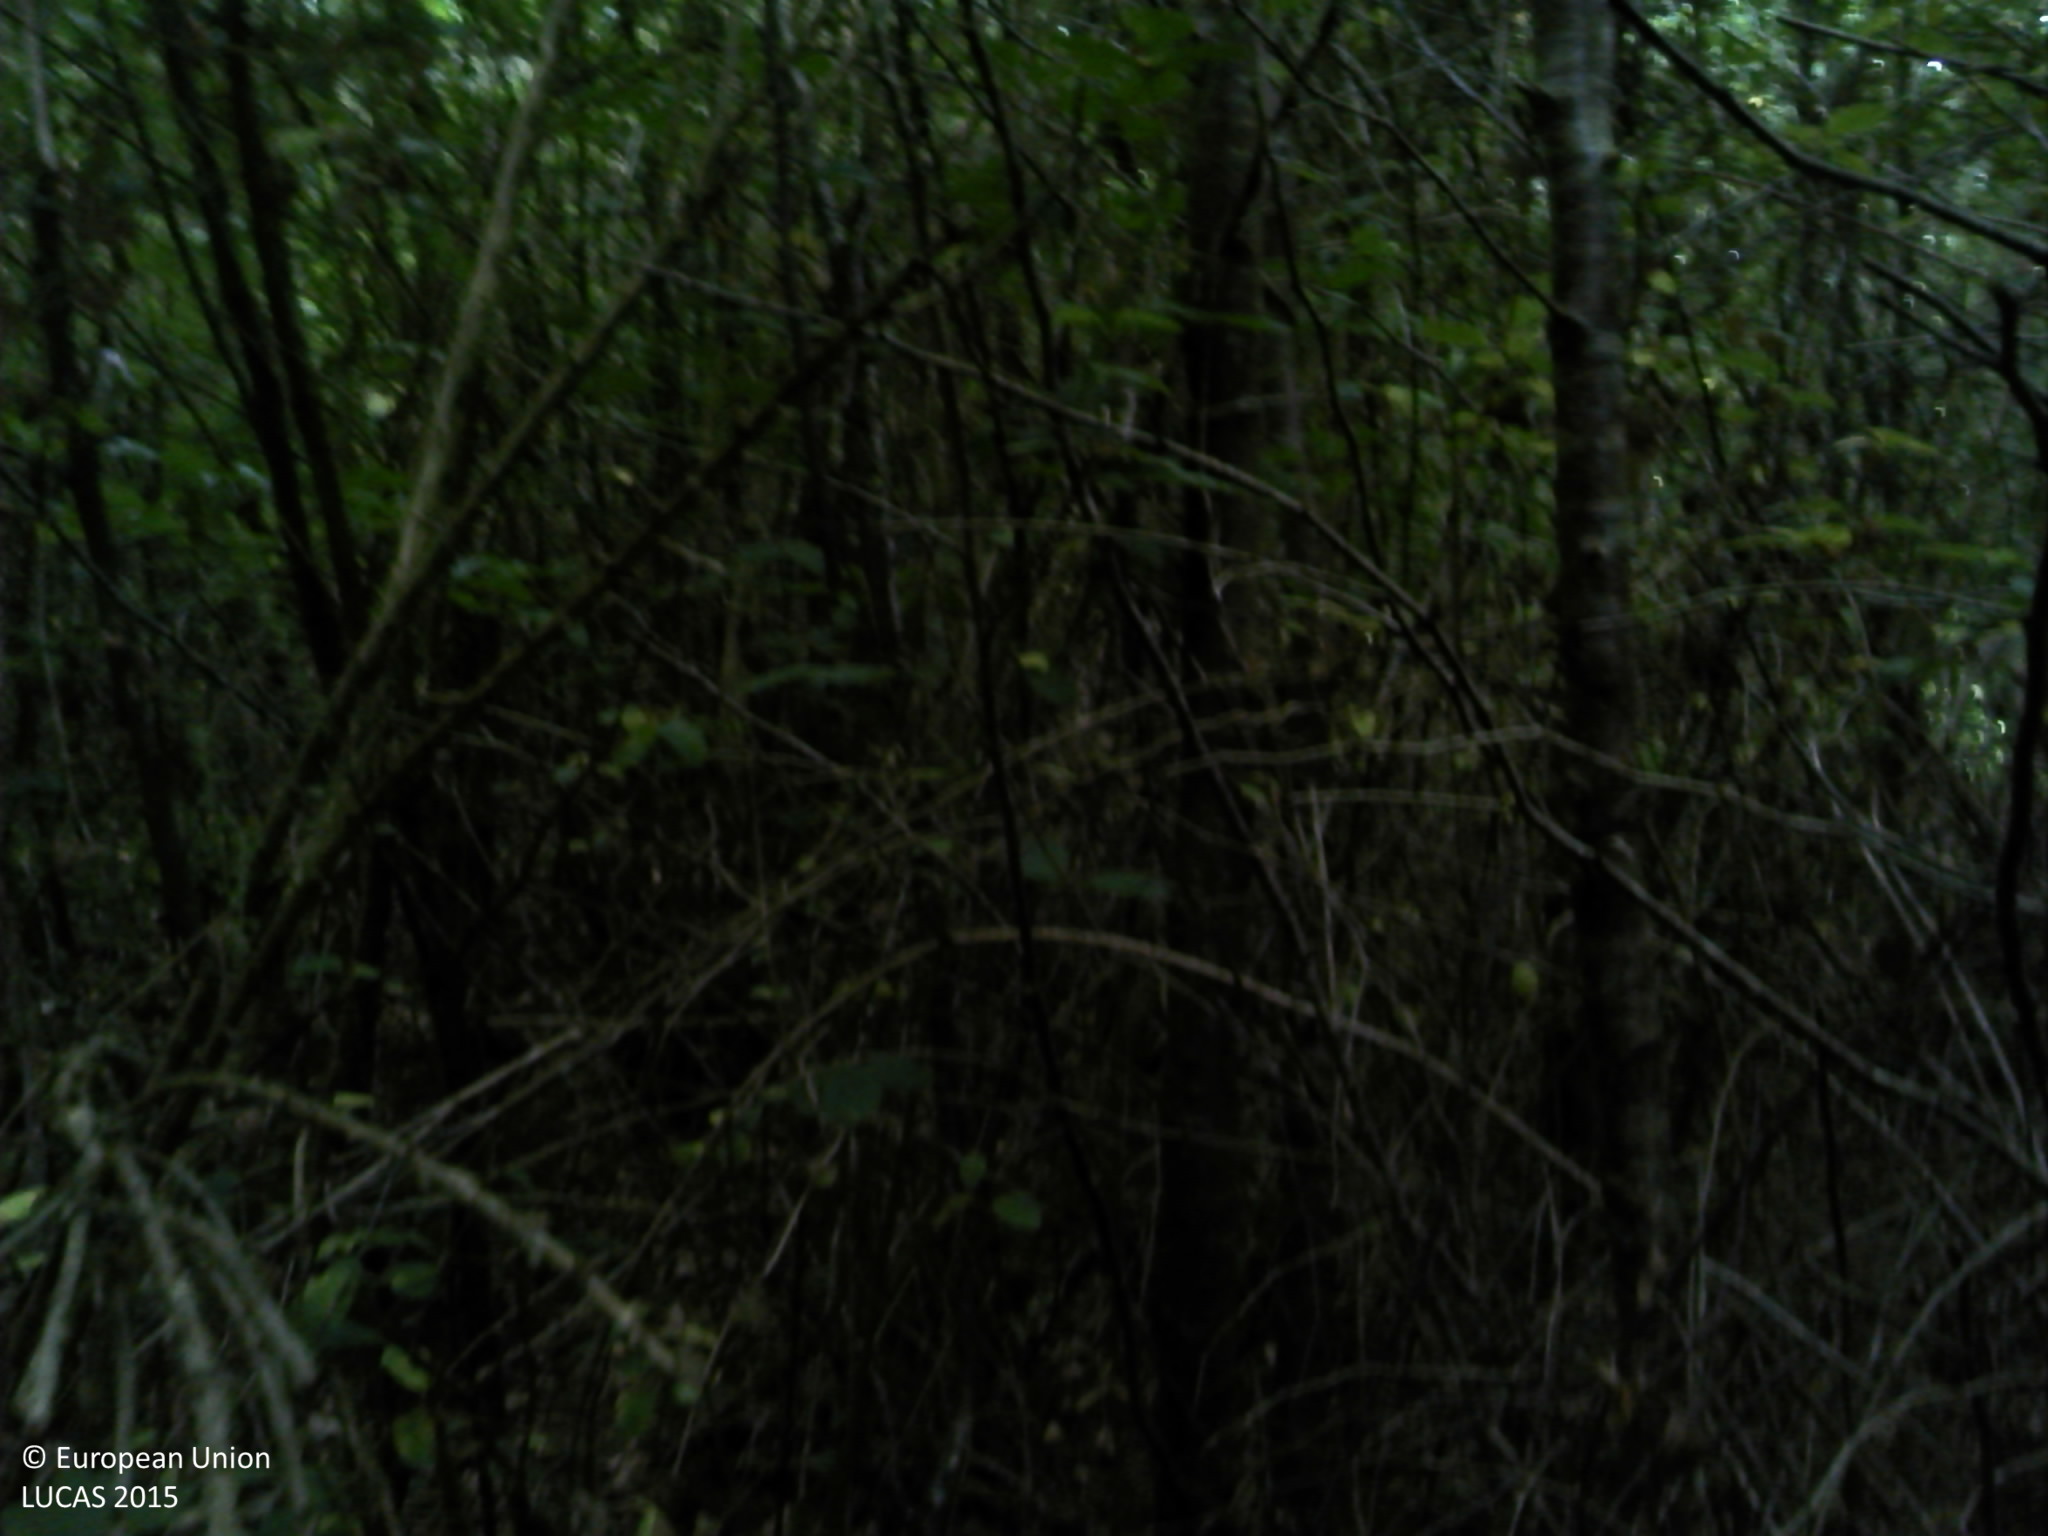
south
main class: Woodland
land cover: Broadleaved woodland
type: mesophytic deciduous forest
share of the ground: > 75 %
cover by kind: broadleaved forest trees 90 %, shrubs 10 %
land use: Forestry
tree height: > 5 m
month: July
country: FR
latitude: 48.4431
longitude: -4.2474
